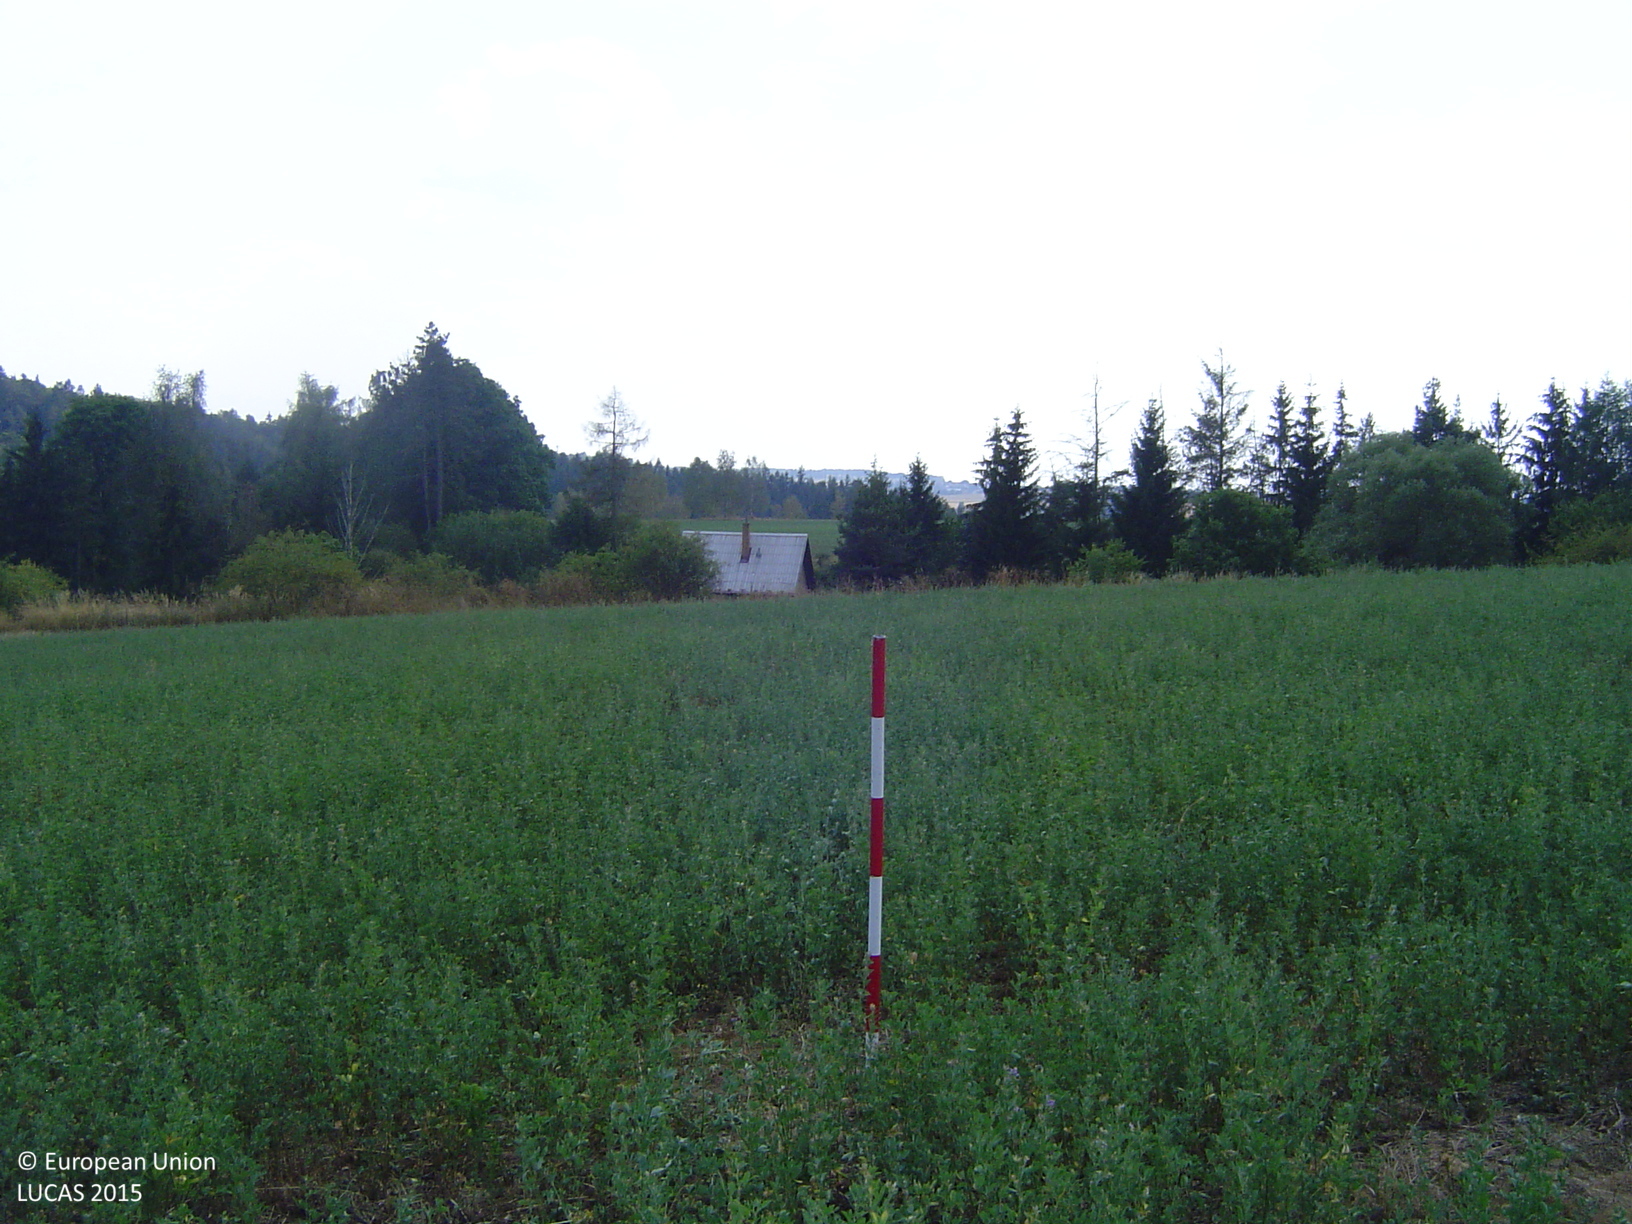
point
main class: Cropland
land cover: Lucerne
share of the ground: > 75 %
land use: Agriculture (excluding fallow land and kitchen gardens)
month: August
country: CZ
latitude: 50.0947
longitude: 14.0408
